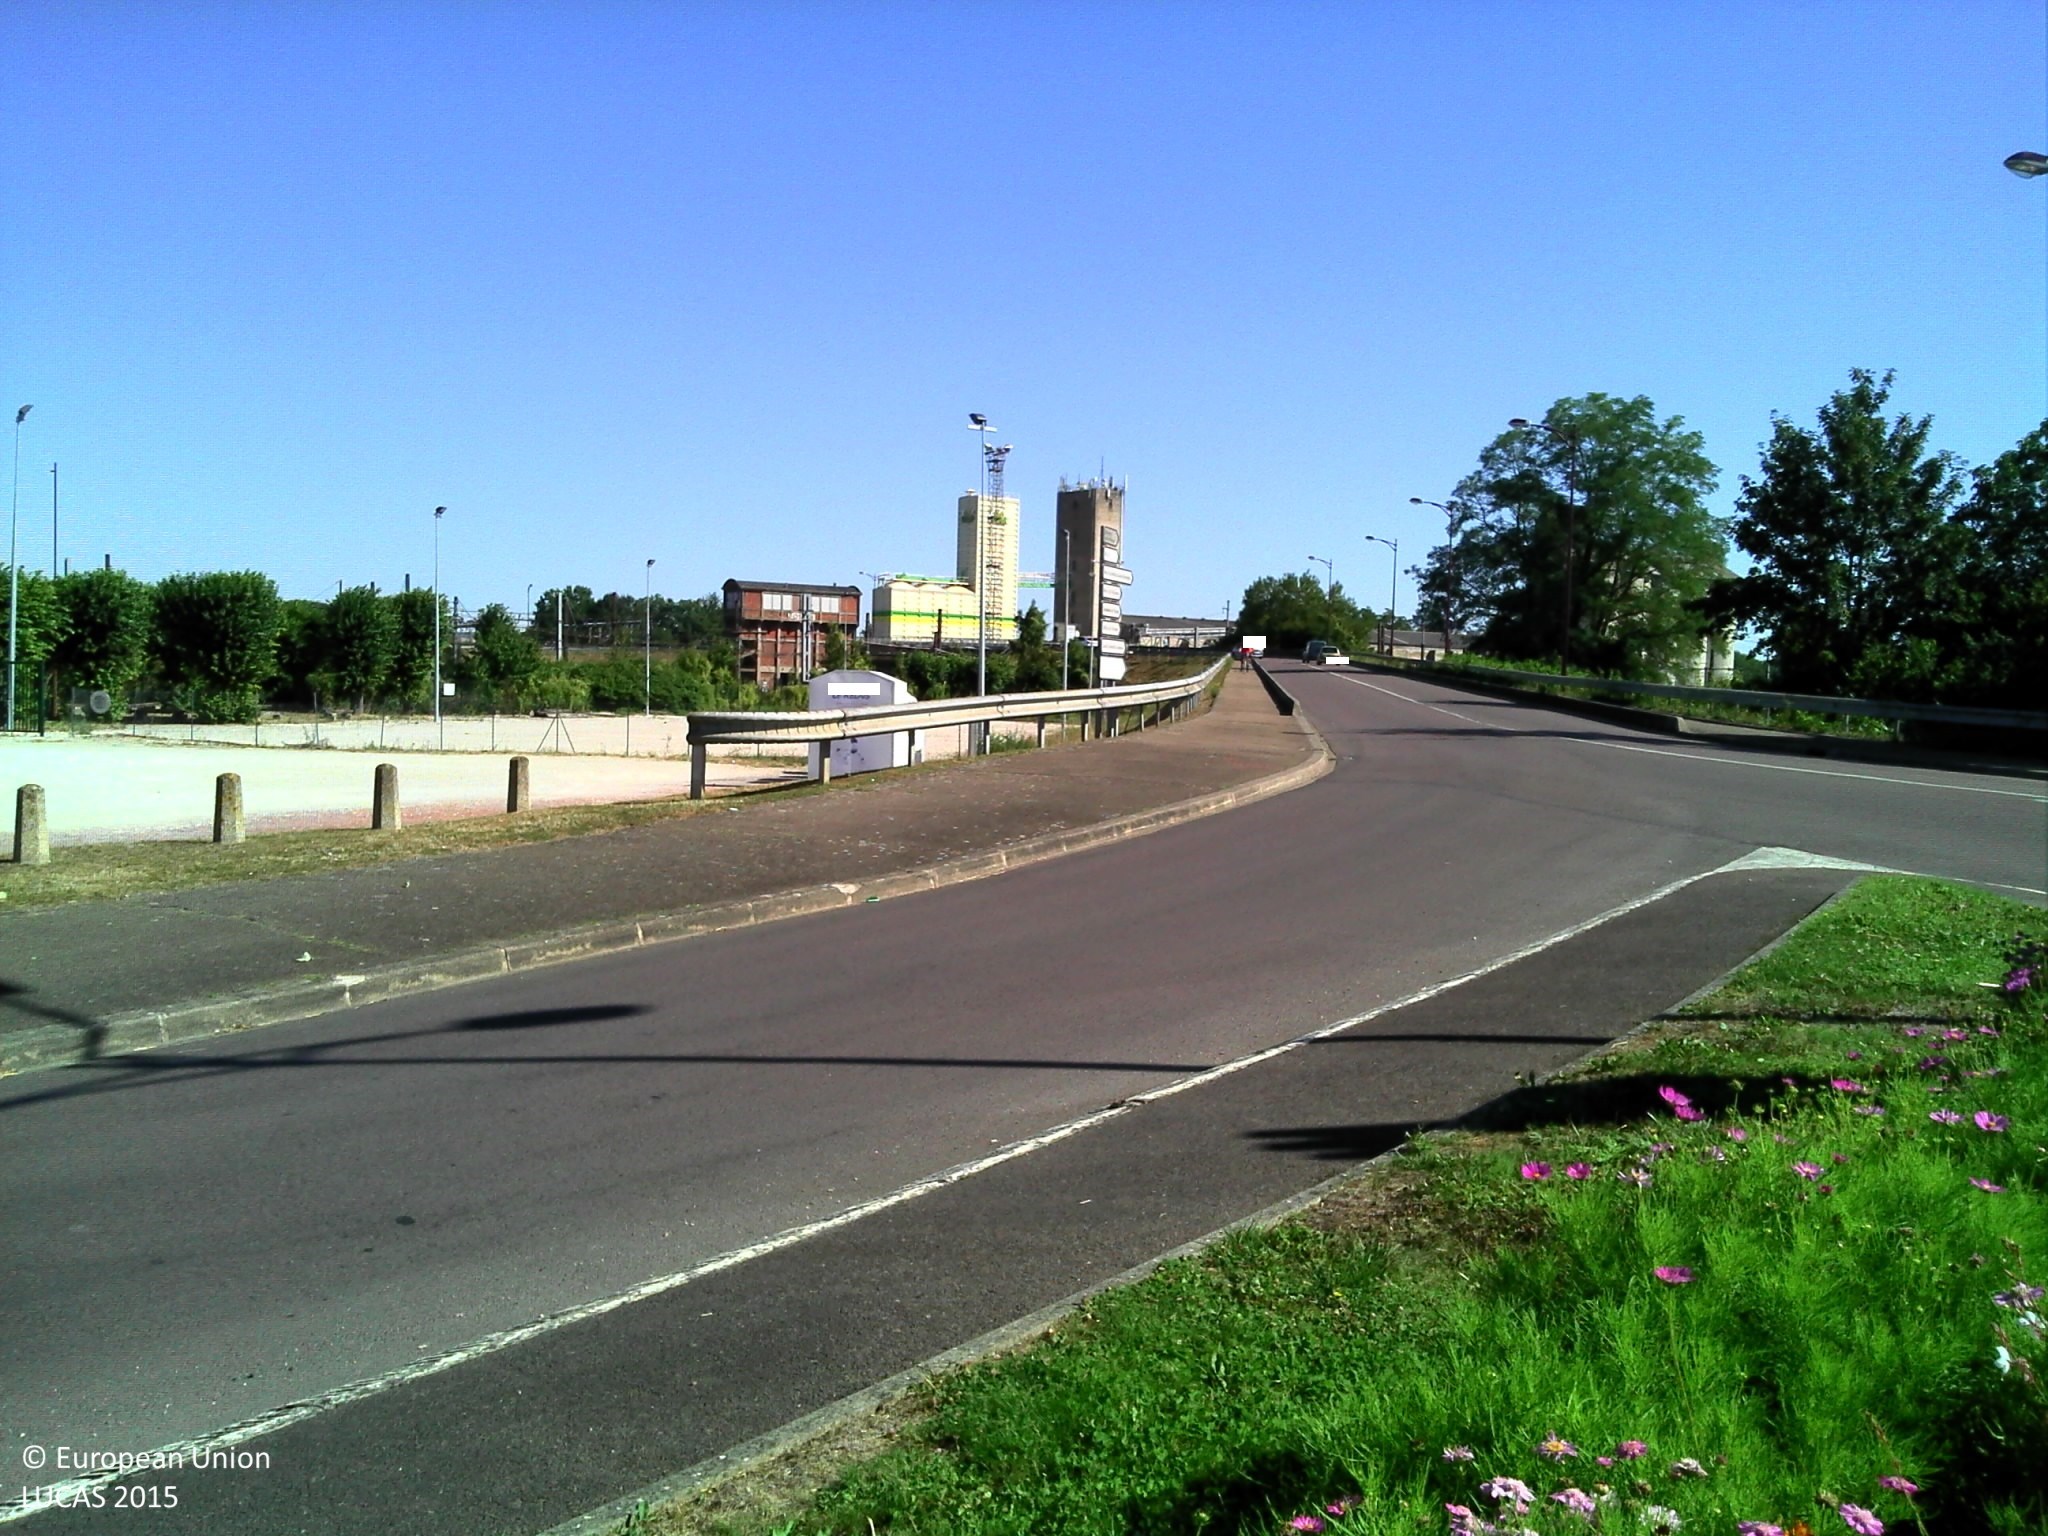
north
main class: Cropland
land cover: Floriculture and ornamental plants
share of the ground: > 75 %
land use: Community services
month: August
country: FR
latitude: 47.9610
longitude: 3.5266
